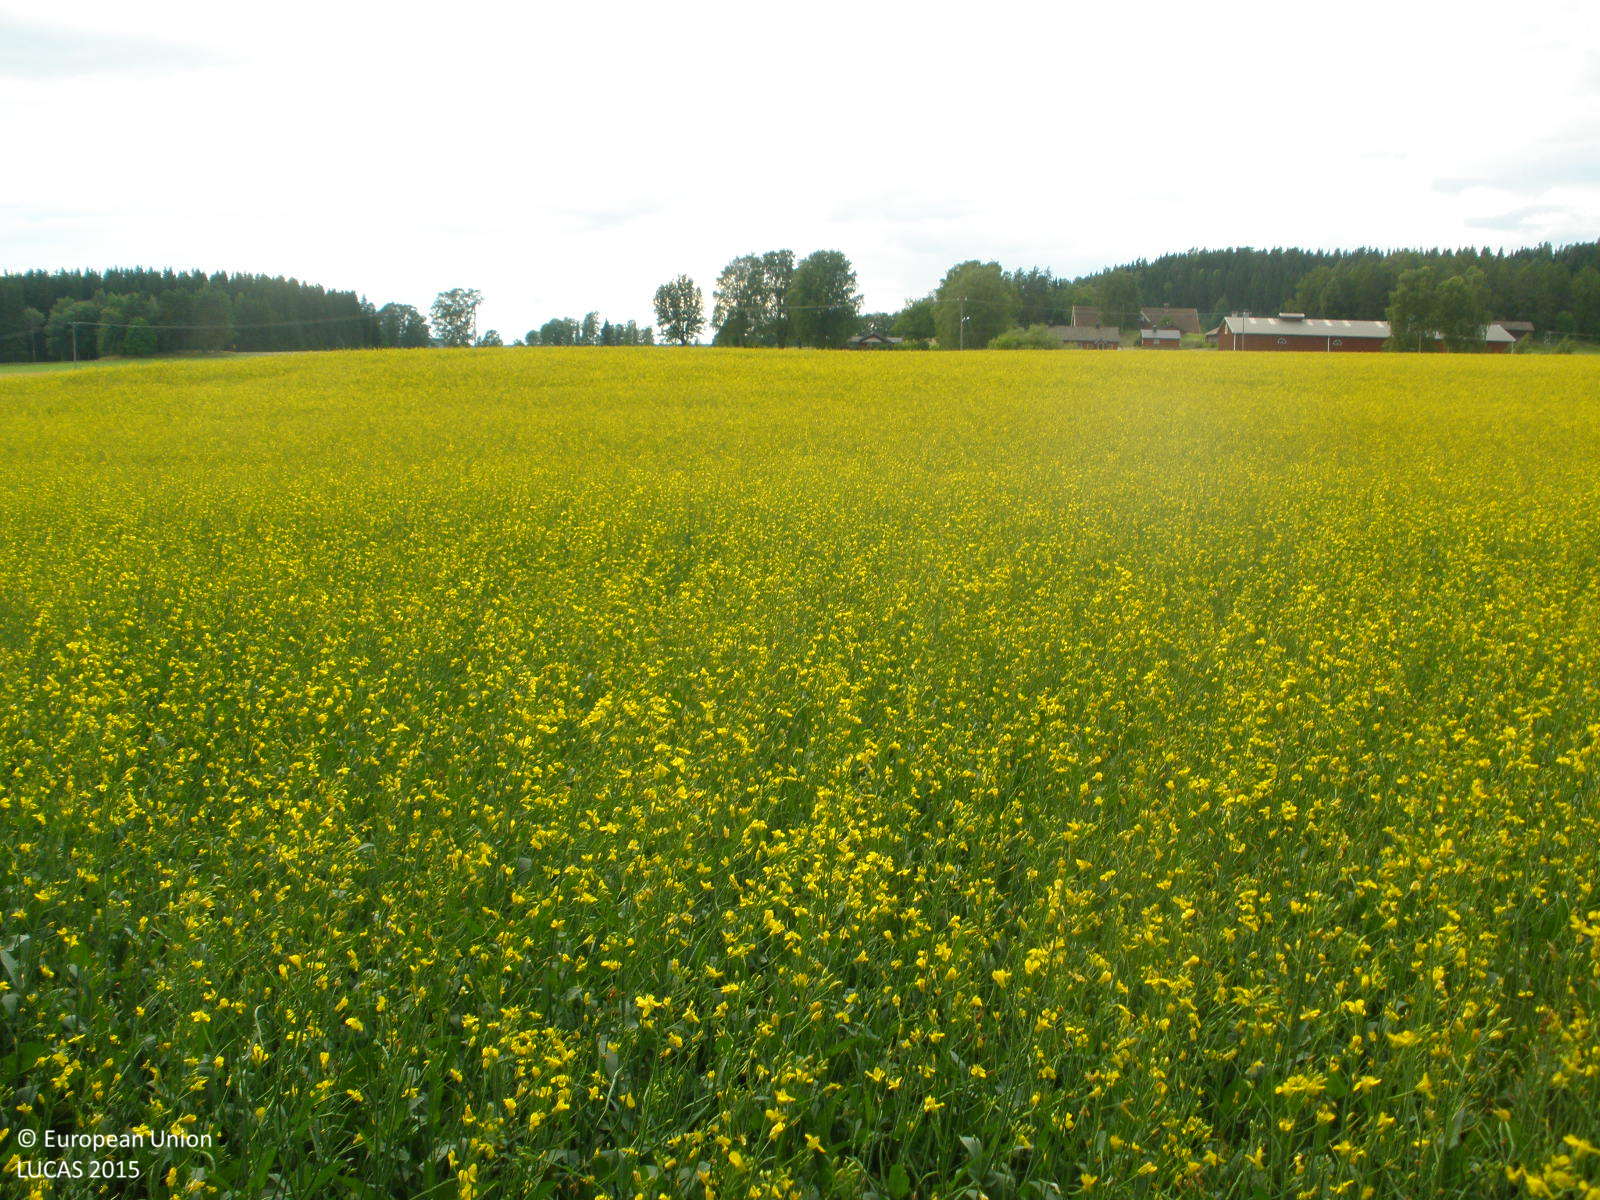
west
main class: Cropland
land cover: Rape and turnip rape
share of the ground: > 75 %
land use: Agriculture (excluding fallow land and kitchen gardens)
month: July
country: FI
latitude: 61.0992
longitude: 25.0075
